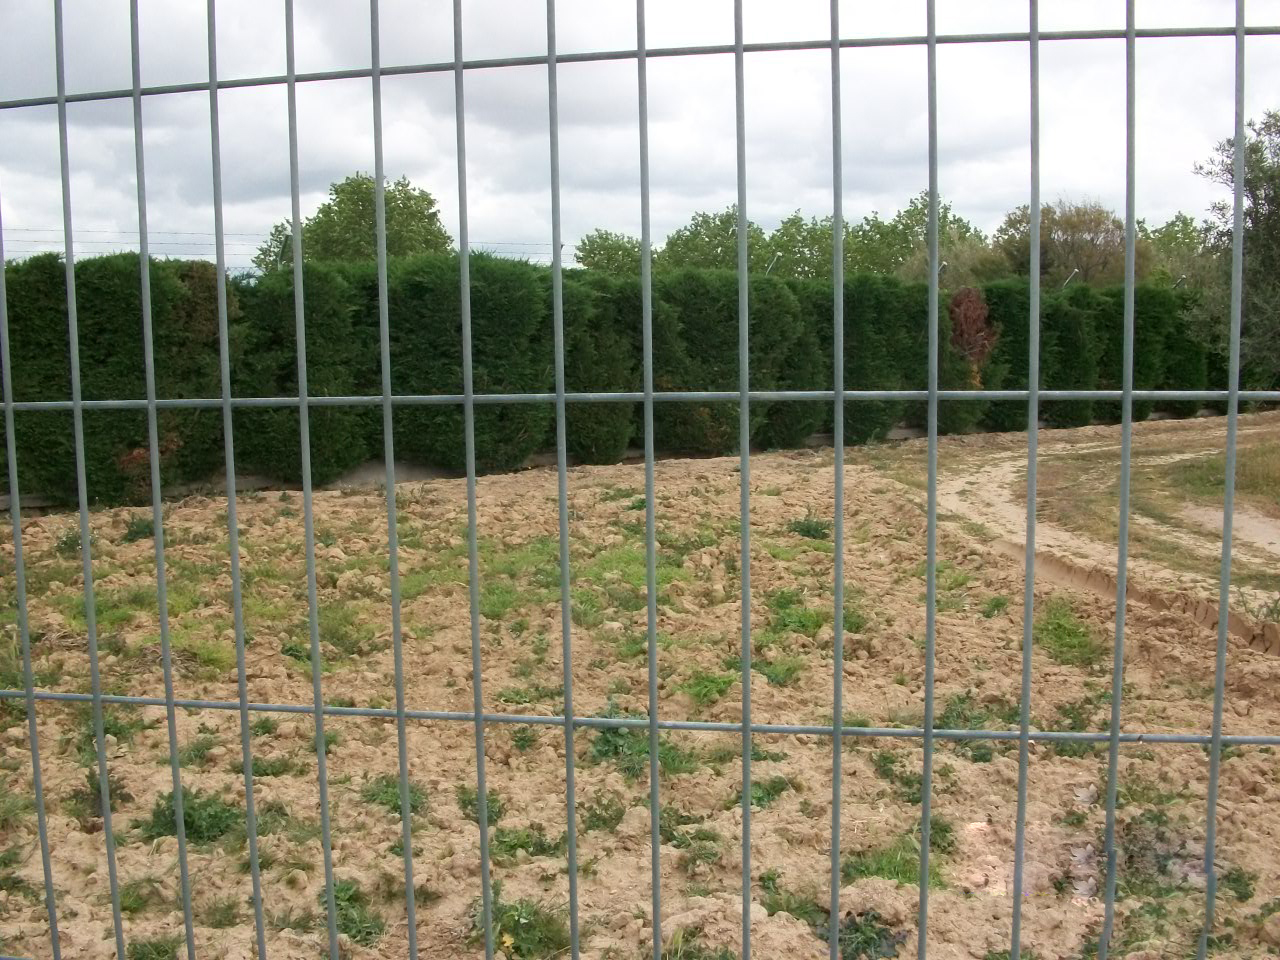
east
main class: Cropland
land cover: Olive groves
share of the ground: 25 - 50 %
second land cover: Grassland without tree/shrub cover
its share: > 75 %
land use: Agriculture (excluding fallow land and kitchen gardens)
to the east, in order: Olive groves; Grassland without tree/shrub cover; Tracks; Managed hedges; Tracks; Lines of trees; Grassland with sparse tree/shrub cover; Lines of trees; Tracks; Lines of trees; Spontaneously vegetated surfaces; Tracks; Grass margins; Managed hedges; Electric lines; Spontaneously vegetated surfaces; Ditches and canals; Grassland without tree/shrub cover; Paved roads, cycling and walking lanes; Grassland without tree/shrub cover; Paved roads, cycling and walking lanes; Grassland without tree/shrub cover; Ditches and canals; Tracks; Ditches and canals; Spontaneously vegetated surfaces; Electric lines; Arable land (only in case pi); Grass margins; Arable land (only in case pi)
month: April
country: ES
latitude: 40.2298
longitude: -3.8703
